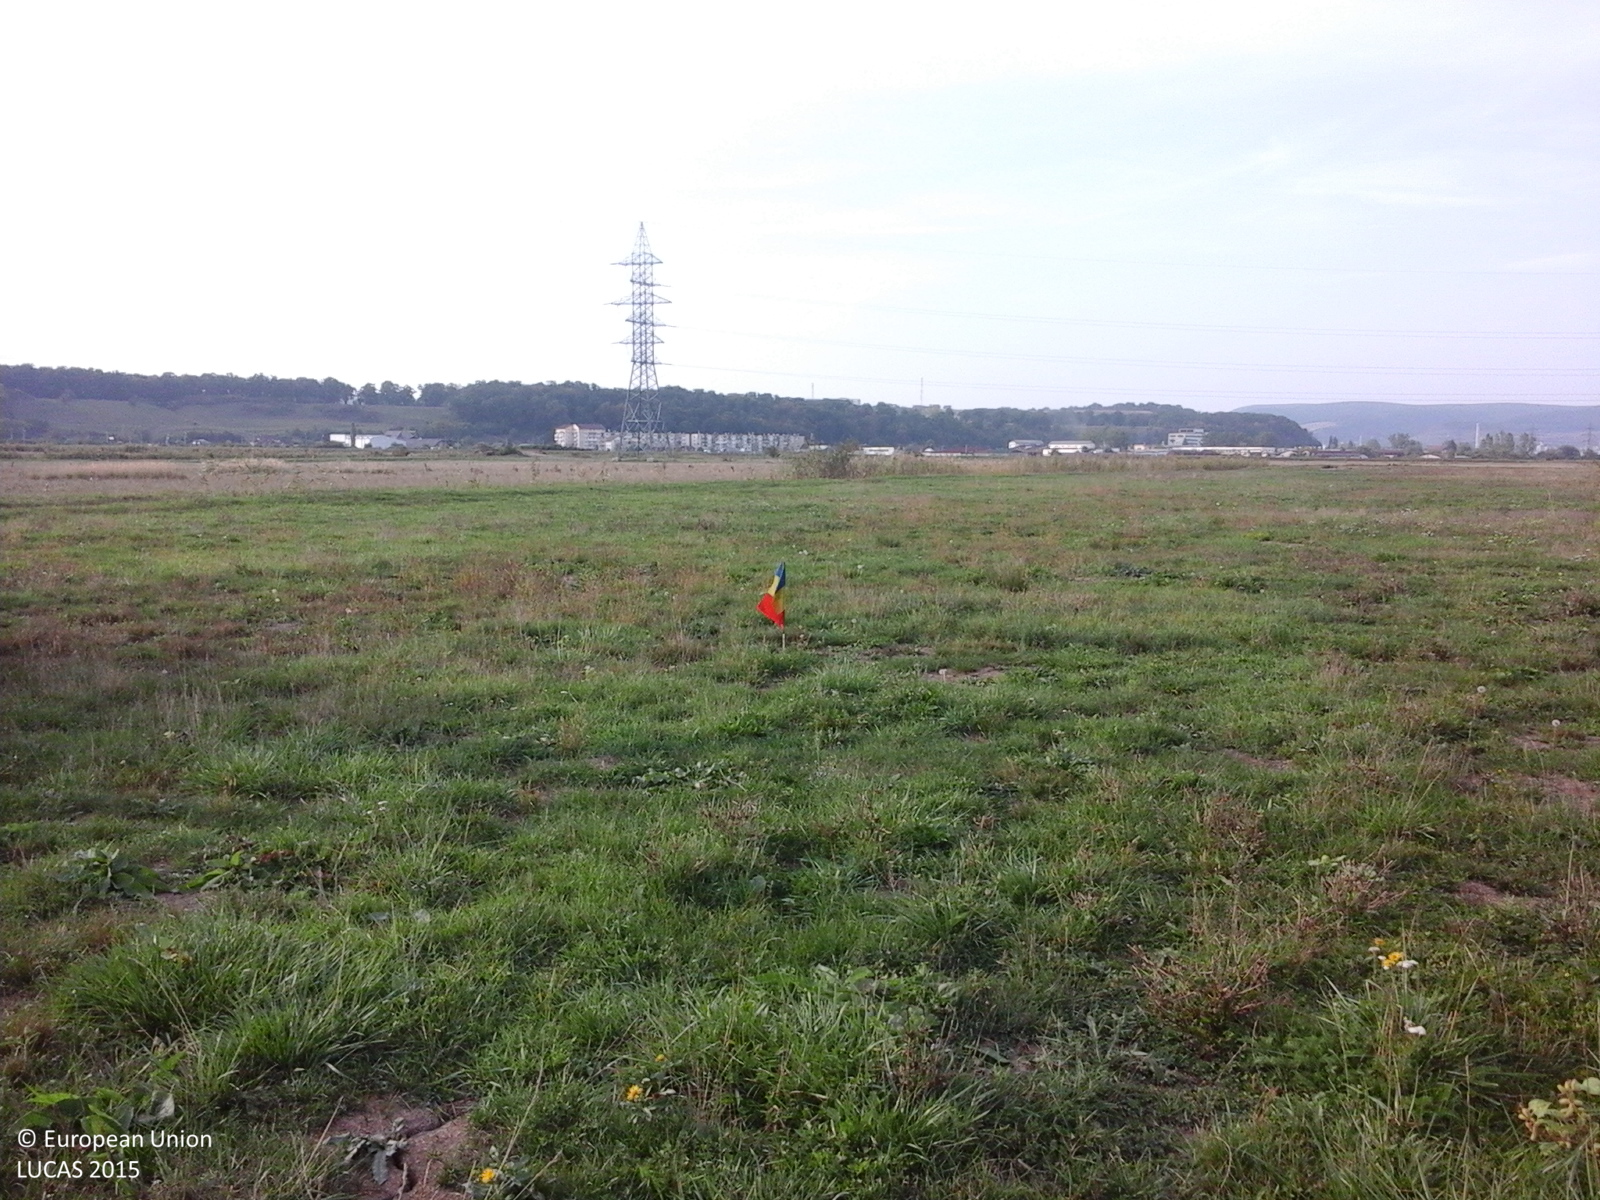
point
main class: Grassland
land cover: Grassland without tree/shrub cover
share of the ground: > 75 %
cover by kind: herbaceous plants 100 %
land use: Agriculture (excluding fallow land and kitchen gardens)
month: September
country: RO
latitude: 47.1178
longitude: 23.9050
